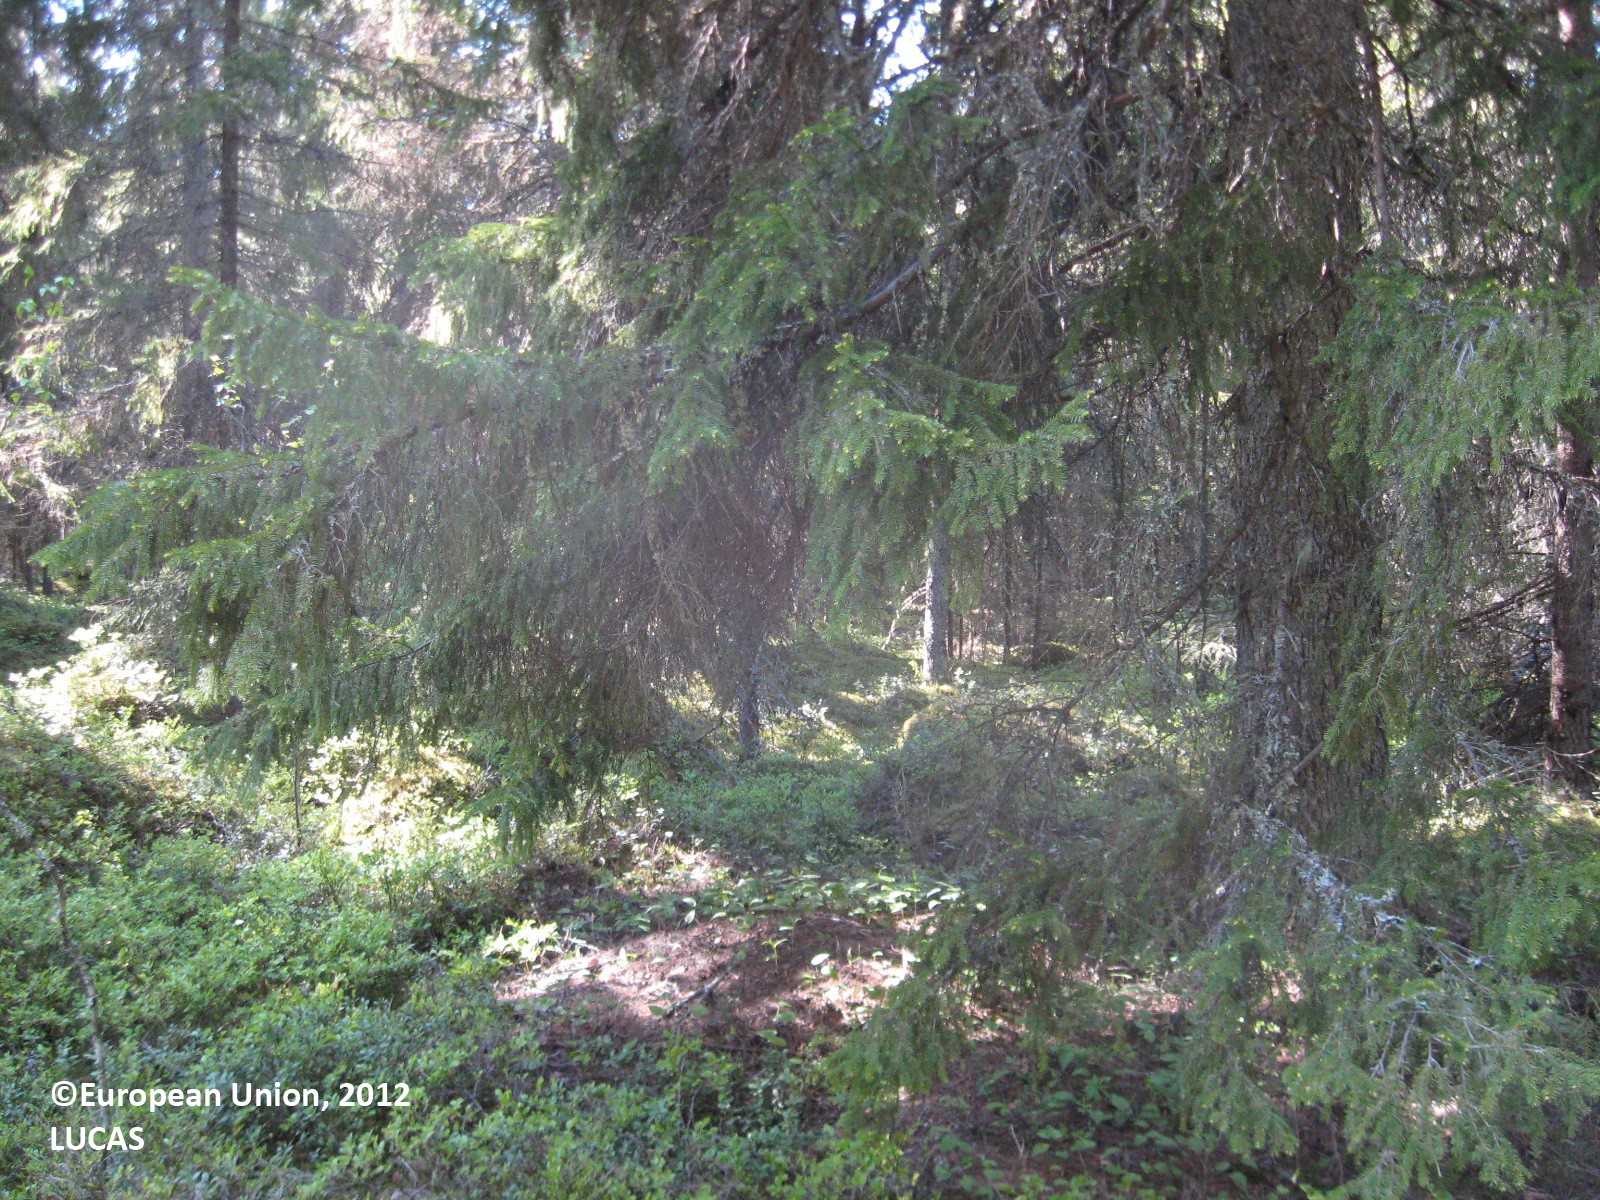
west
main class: Woodland
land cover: Spruce dominated coniferous woodland
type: boreal forest
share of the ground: > 75 %
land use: Forestry
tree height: > 5 m
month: June
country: FI
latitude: 63.2546
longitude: 21.4093
